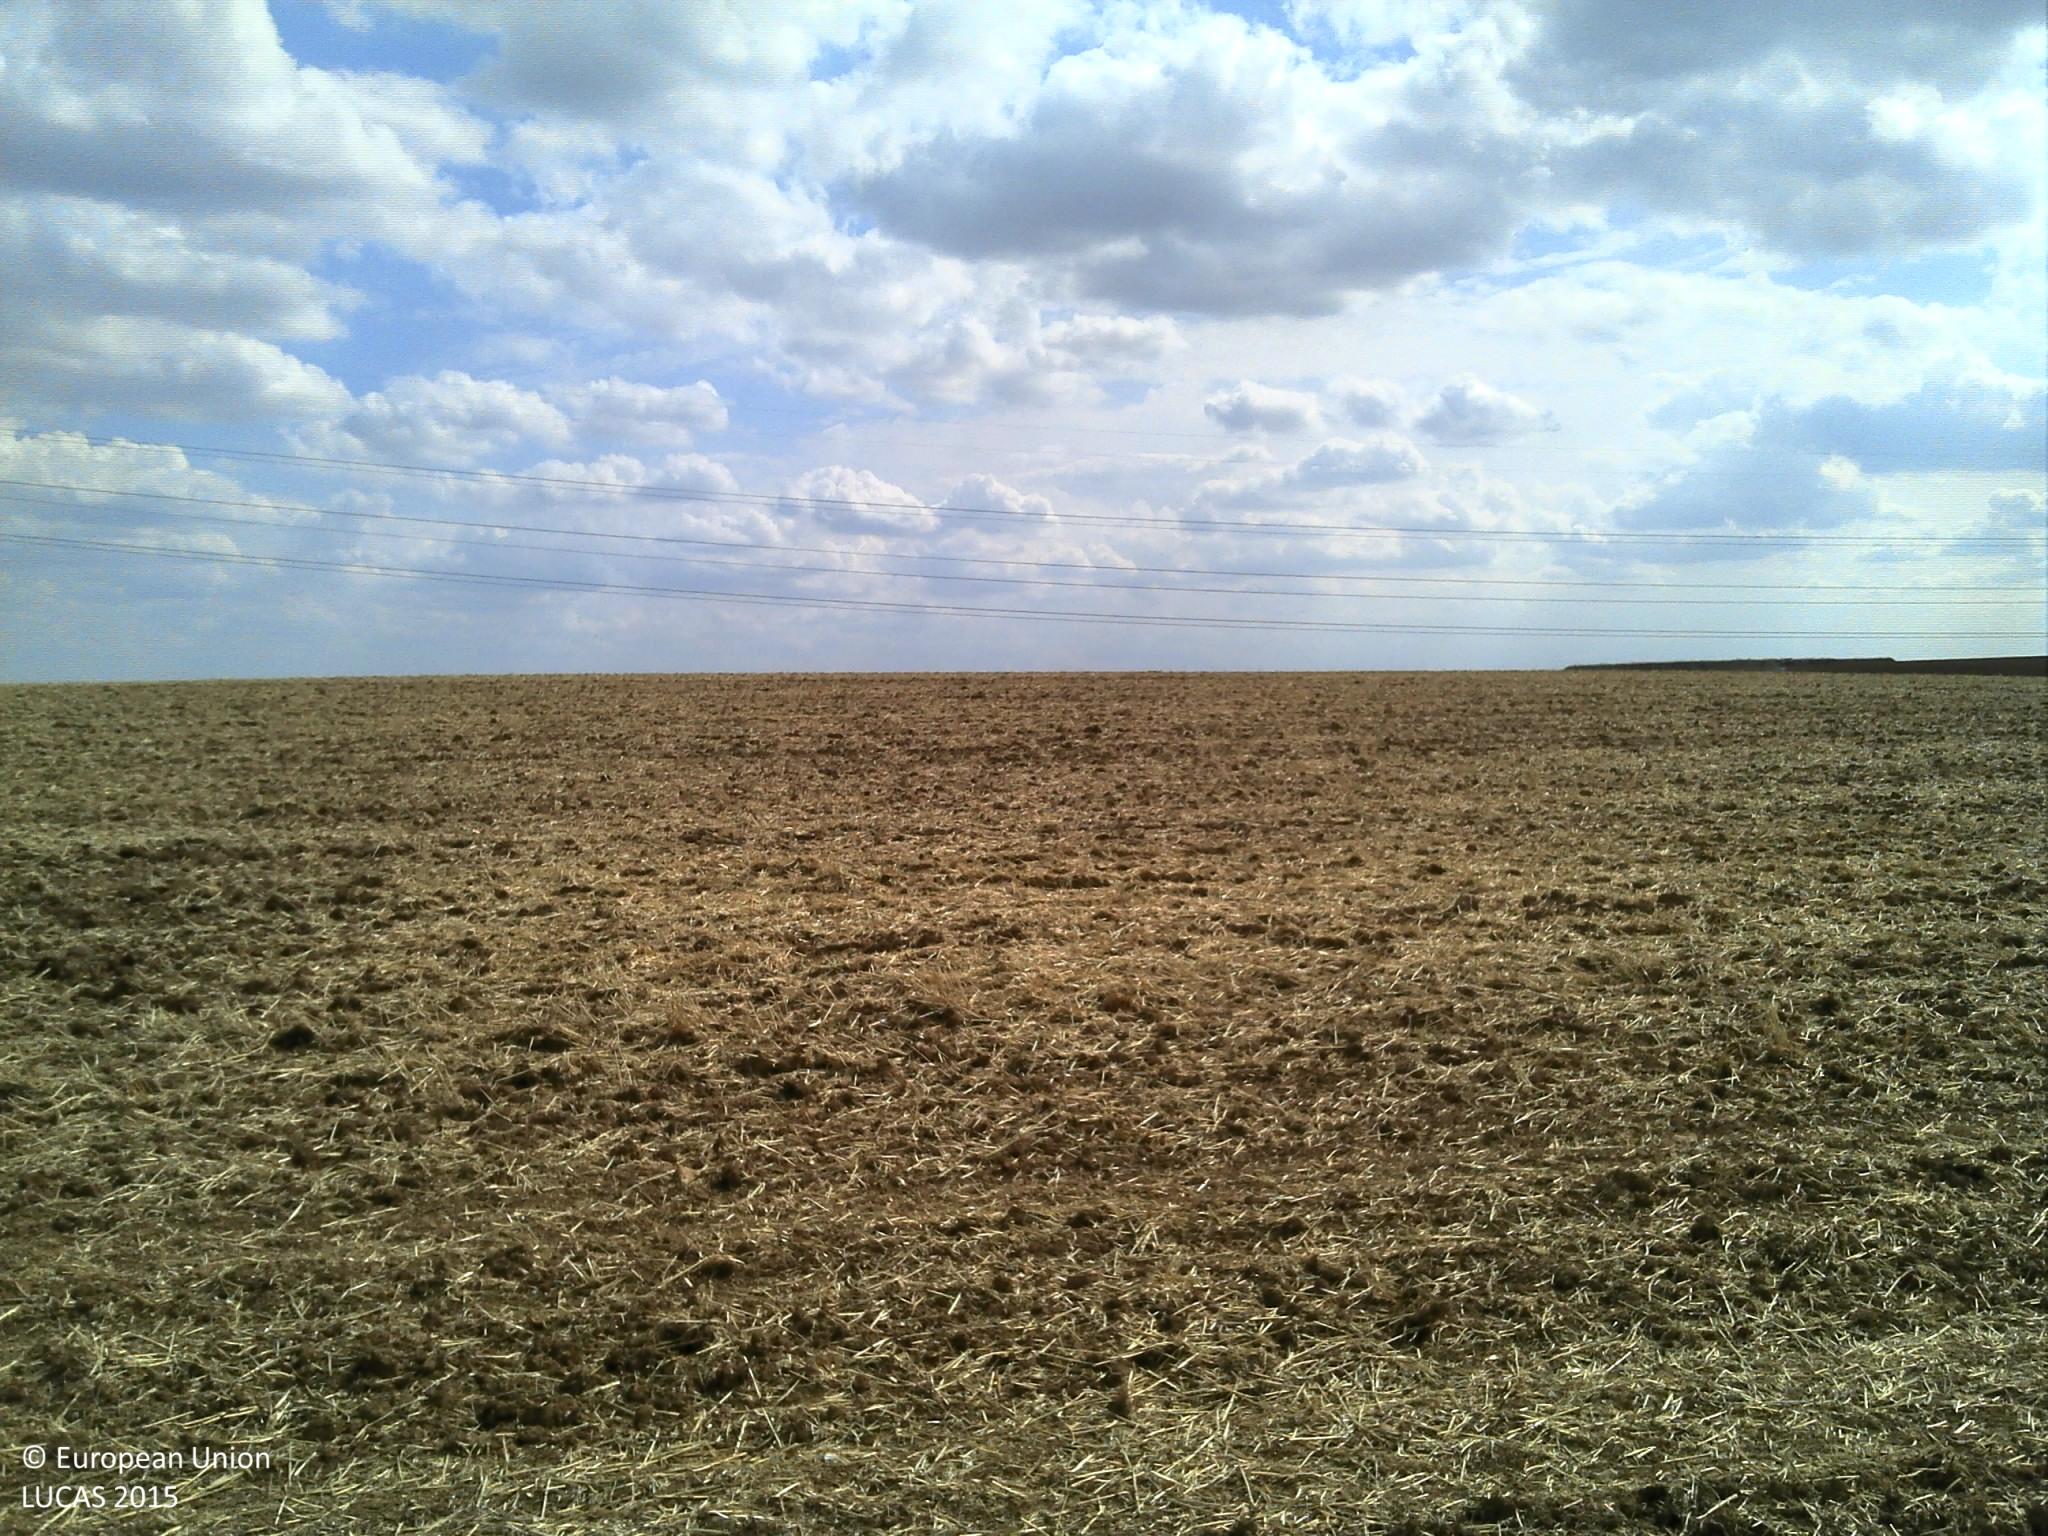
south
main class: Cropland
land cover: Common wheat
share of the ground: 25 - 50 %
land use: Agriculture (excluding fallow land and kitchen gardens)
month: August
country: FR
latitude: 48.4447
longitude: 3.4643
